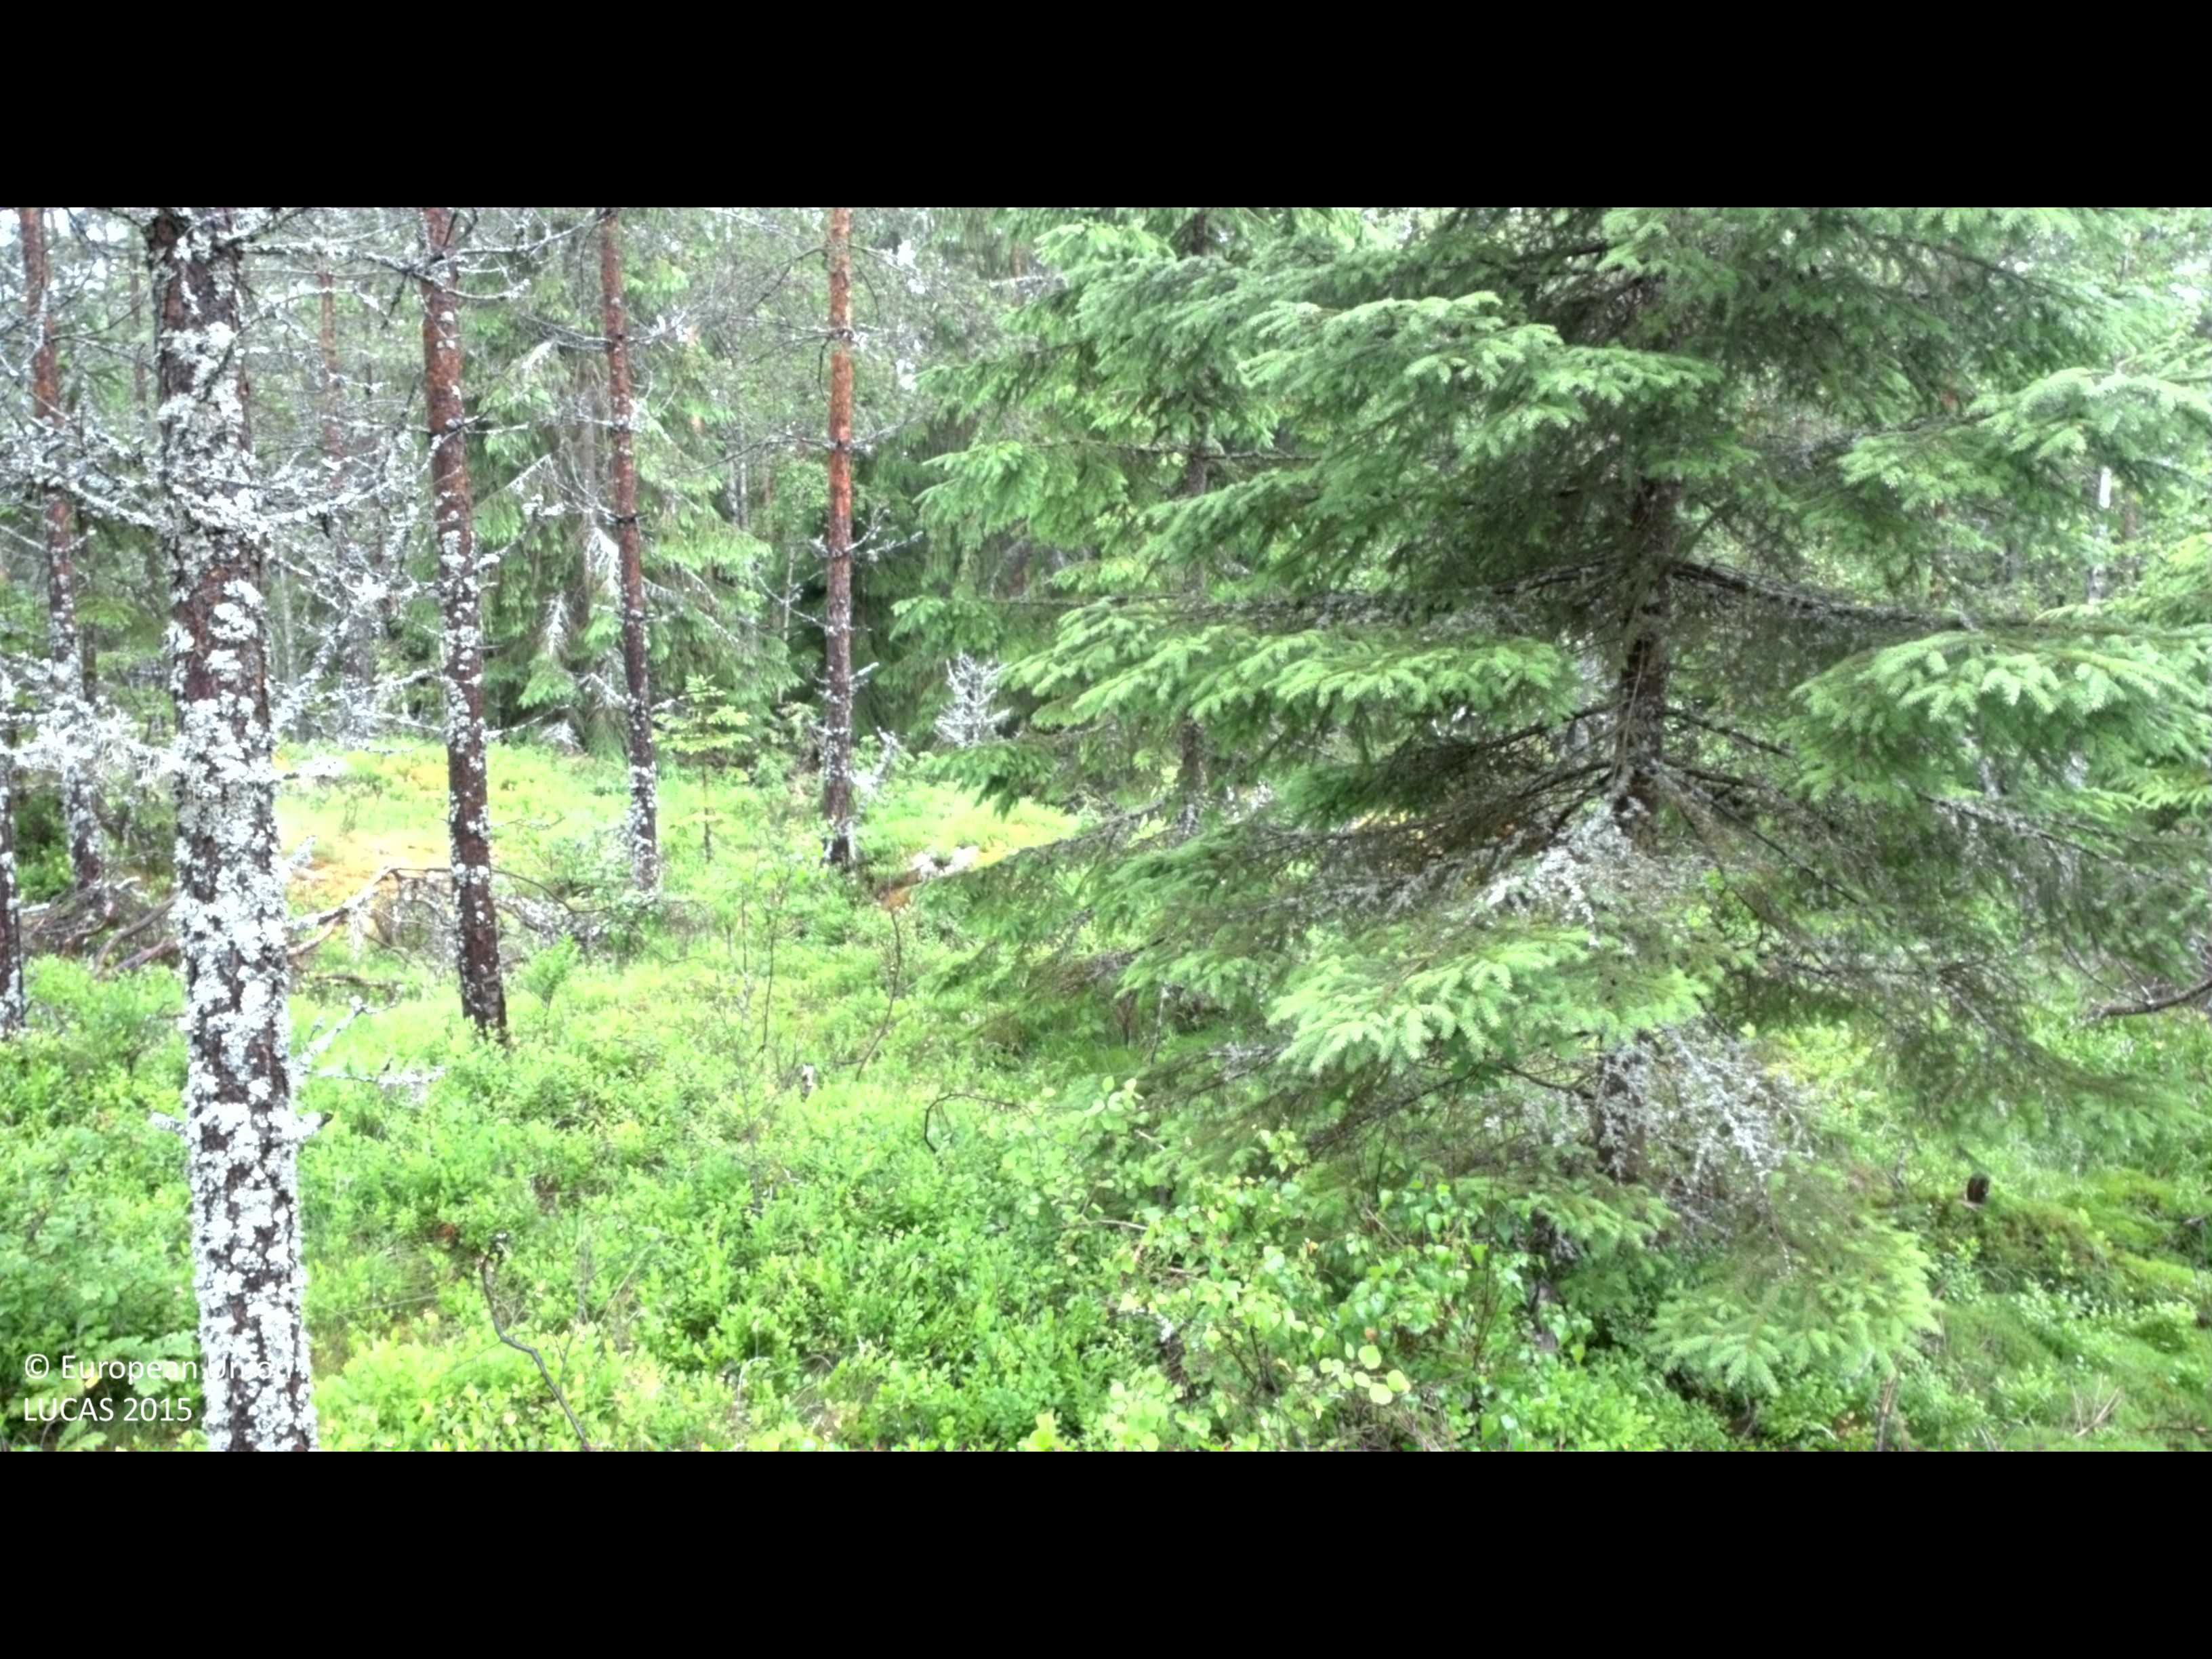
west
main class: Woodland
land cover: Pine dominated mixed woodland
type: boreal forest
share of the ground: 25 - 50 %
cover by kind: shrubs 35 %, coniferous forest trees 30 %, broadleaved forest trees 20 %, lichens and mosses 15 %
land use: Forestry
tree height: > 5 m
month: June
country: SE
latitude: 58.0449
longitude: 16.4857
